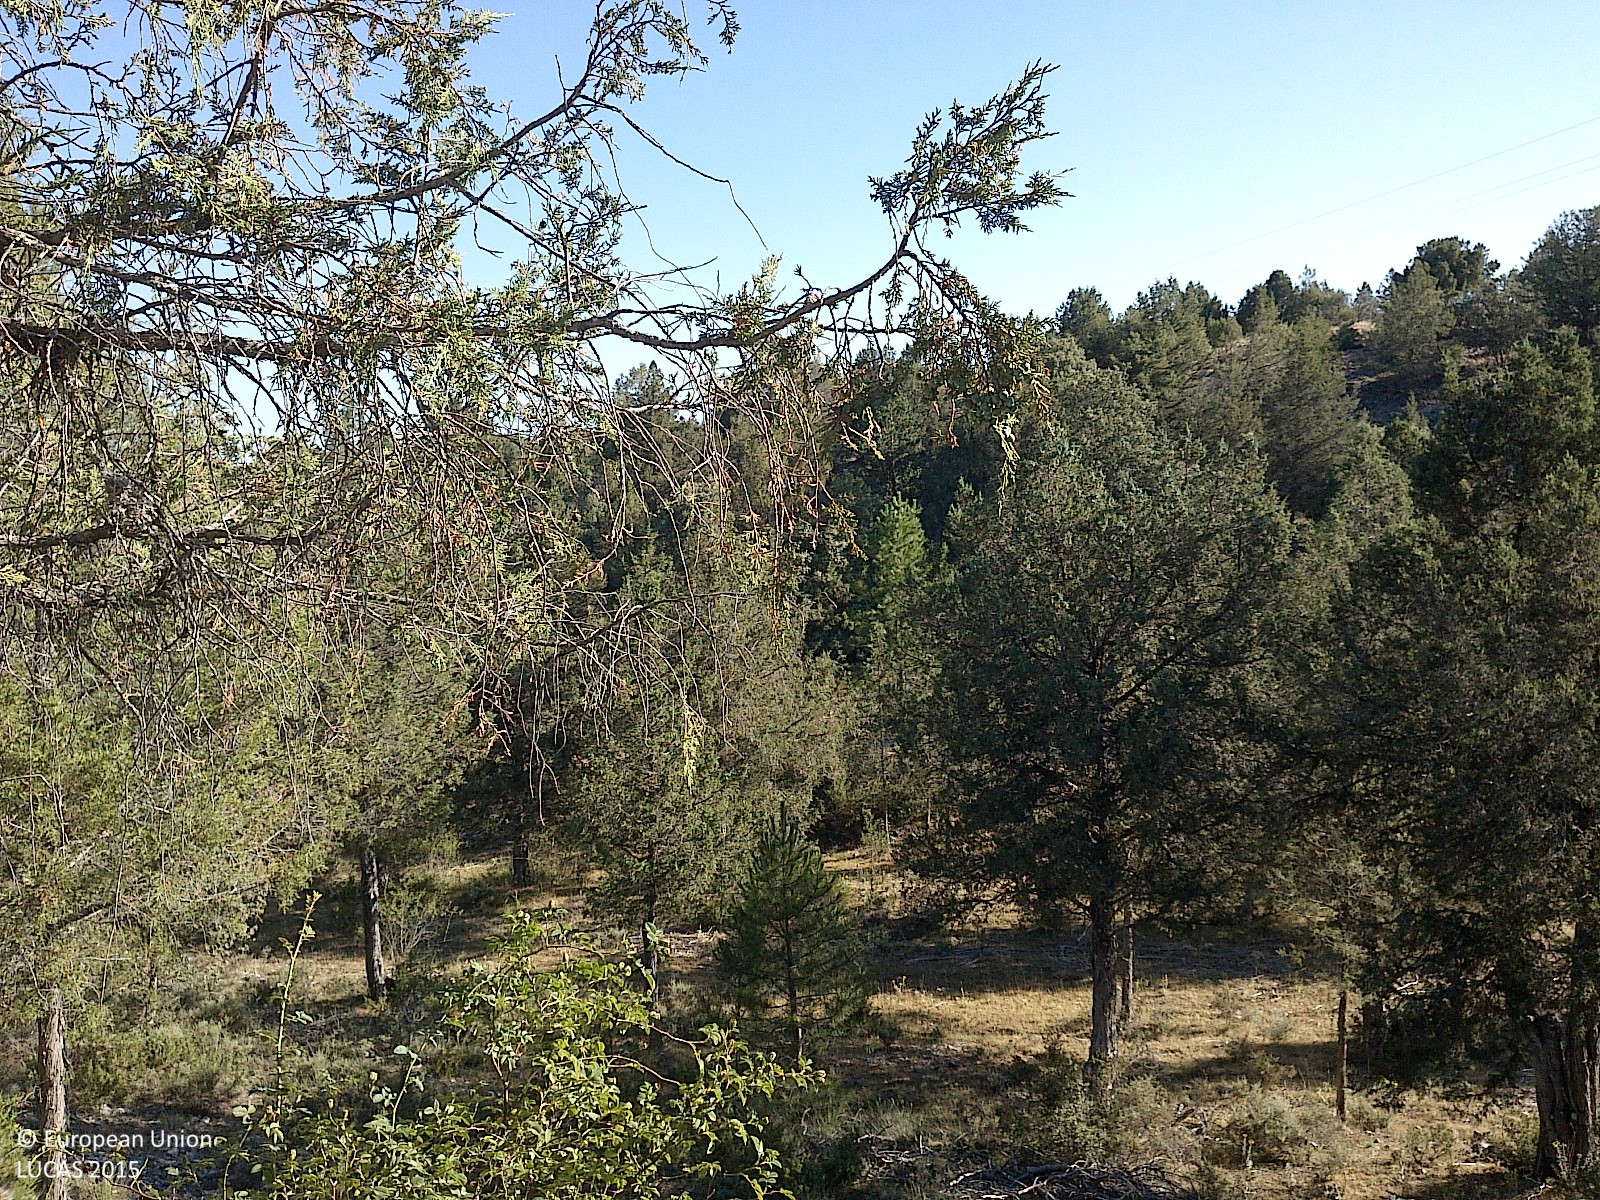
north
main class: Woodland
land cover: Other coniferous woodland
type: coniferous forest of the mediterranean region
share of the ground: 25 - 50 %
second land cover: Shrubland without tree cover
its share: 10 - 25 %
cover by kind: consolidated bare surface 30 %, coniferous forest trees 25 %, herbaceous plants 20 %, shrubs 15 %, broadleaved forest trees 5 %, unconsolidated bare surface 5 %
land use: Forestry
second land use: Agriculture (excluding fallow land and kitchen gardens)
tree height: < 5 m
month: July
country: ES
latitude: 41.8049
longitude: -3.0566
